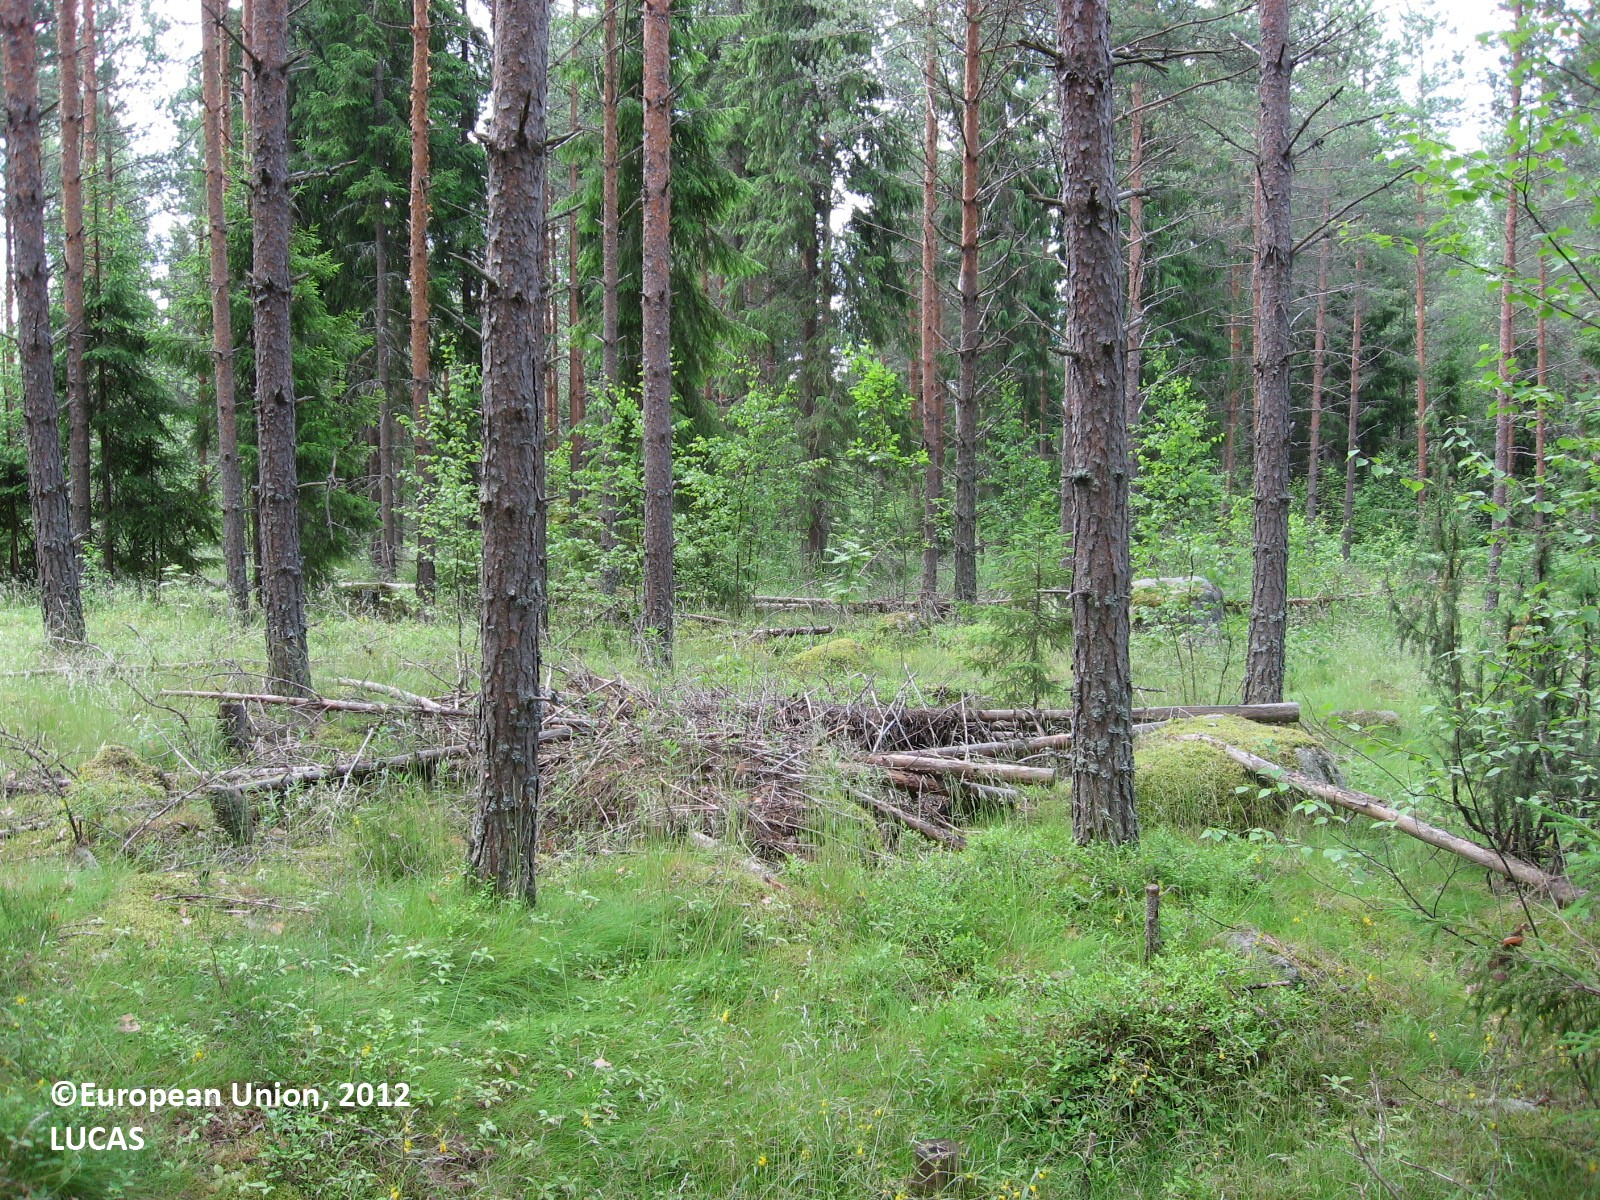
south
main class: Woodland
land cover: Pine dominated coniferous woodland
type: boreal forest
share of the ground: 25 - 50 %
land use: Forestry
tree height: > 5 m
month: June
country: FI
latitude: 60.6926
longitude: 26.5093
